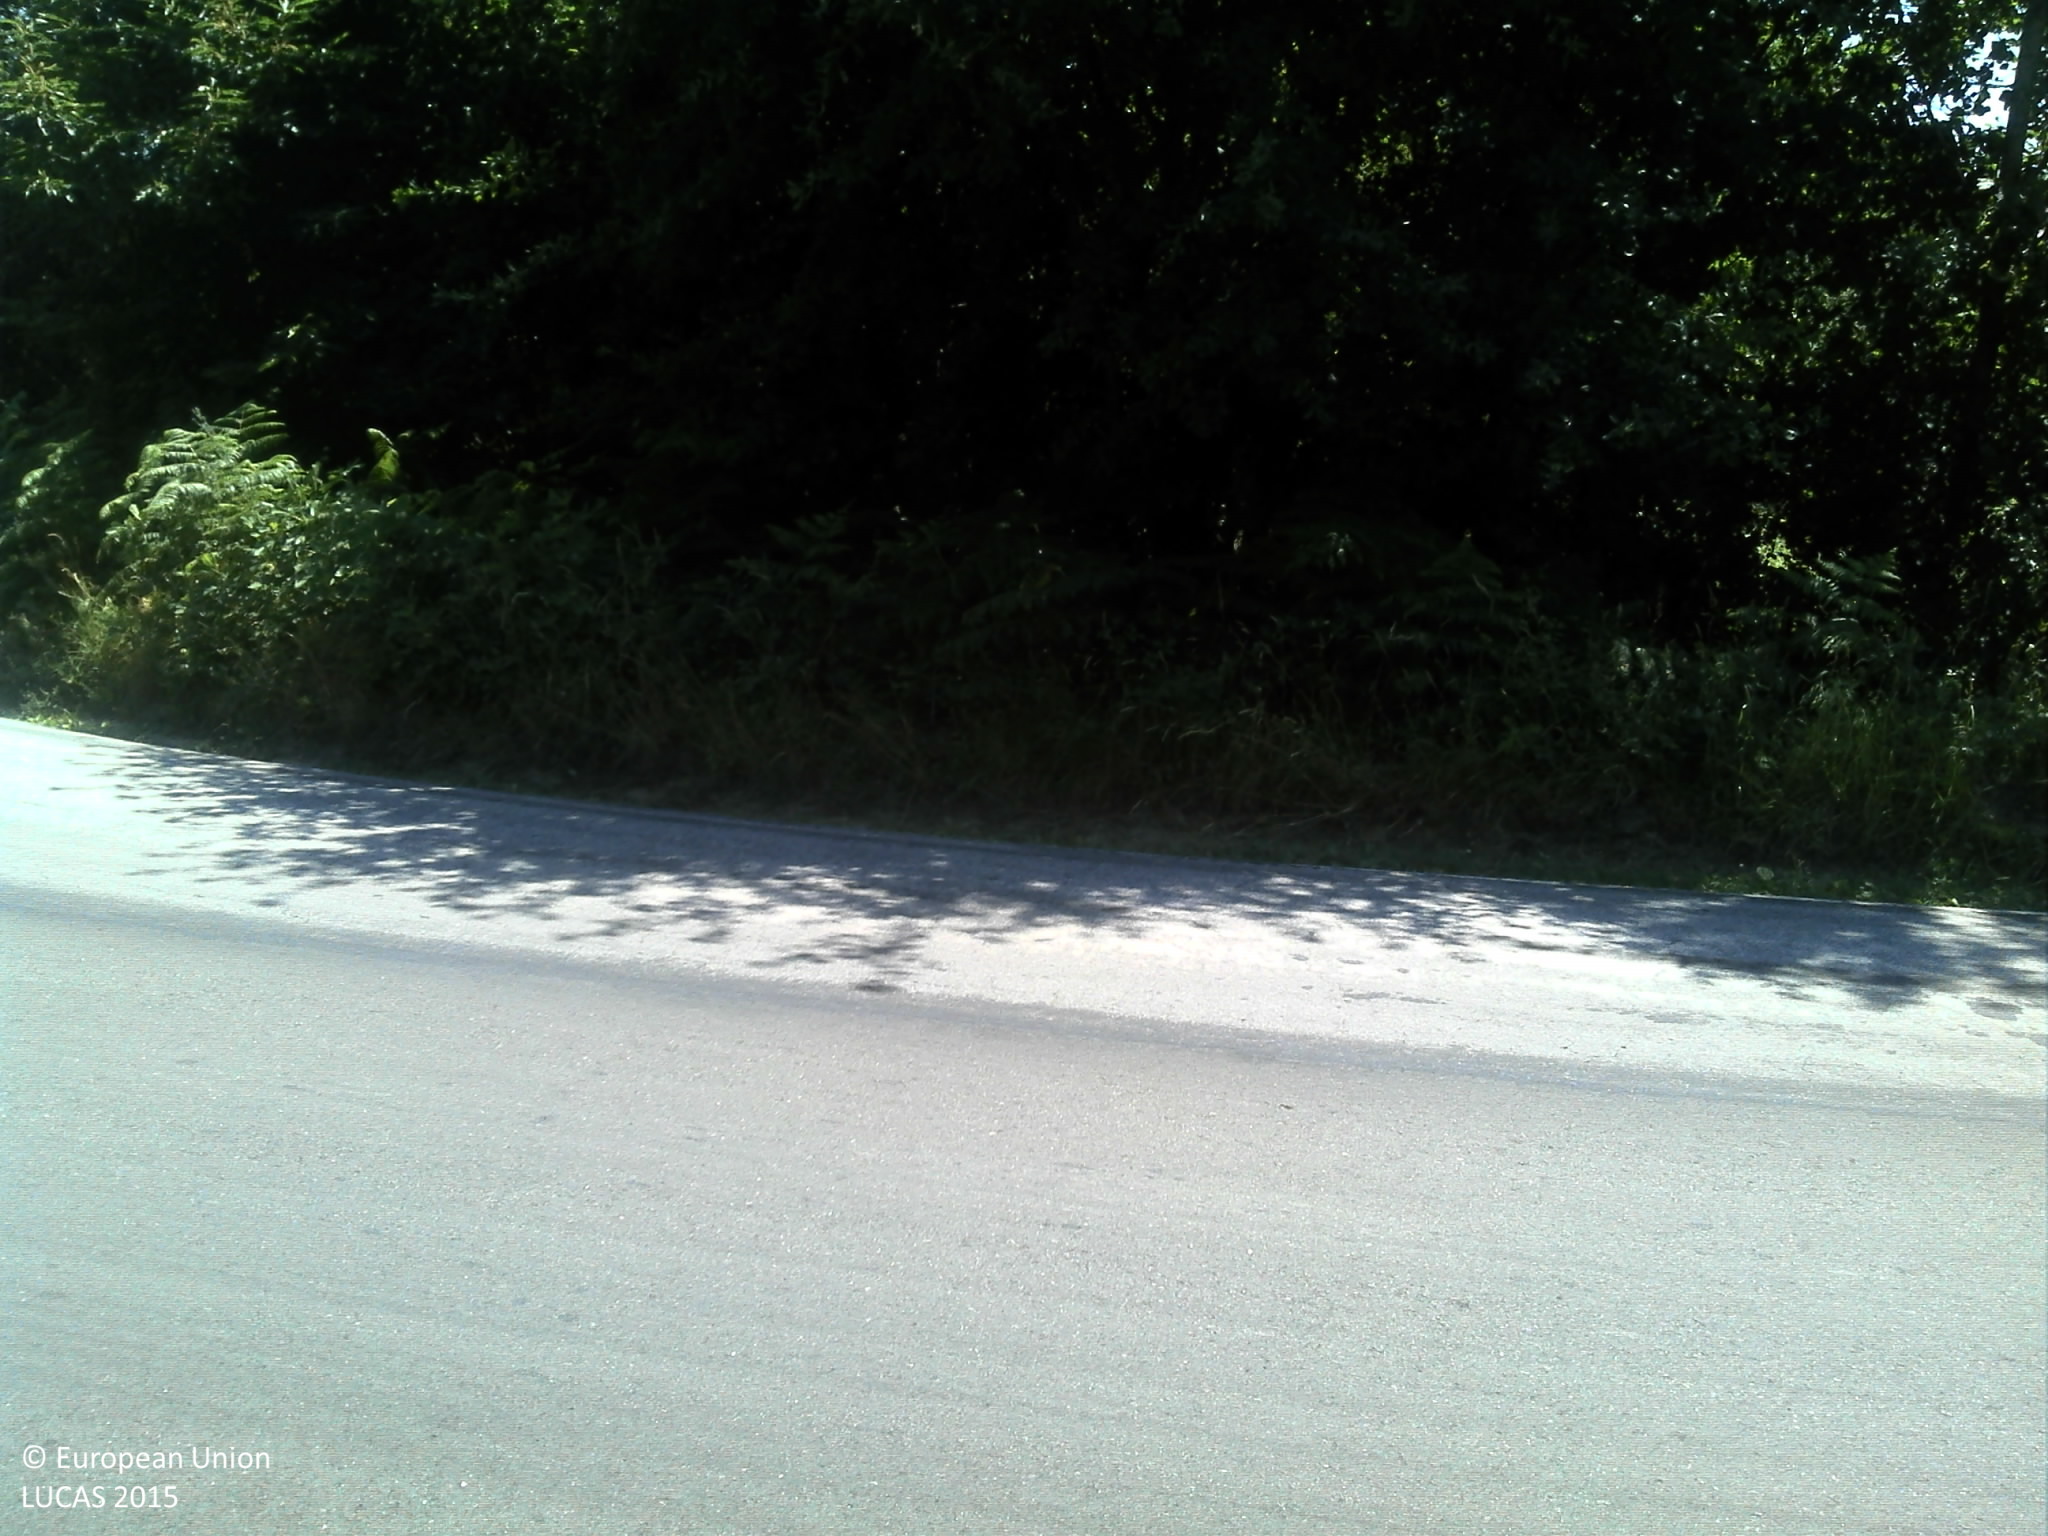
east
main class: Shrubland
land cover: Shrubland without tree cover
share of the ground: > 75 %
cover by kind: shrubs 75 %, consolidated bare surface 15 %, herbaceous plants 10 %
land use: Road transport
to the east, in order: Shrubland without tree cover; Dry stone walls; Vineyards; Shrubland without tree cover; Vineyards; Other fresh vegetables; Vineyards; Artificial constructions in urban areas; Broadleaved woodland
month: June
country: PT
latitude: 41.4174
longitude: -7.9776
